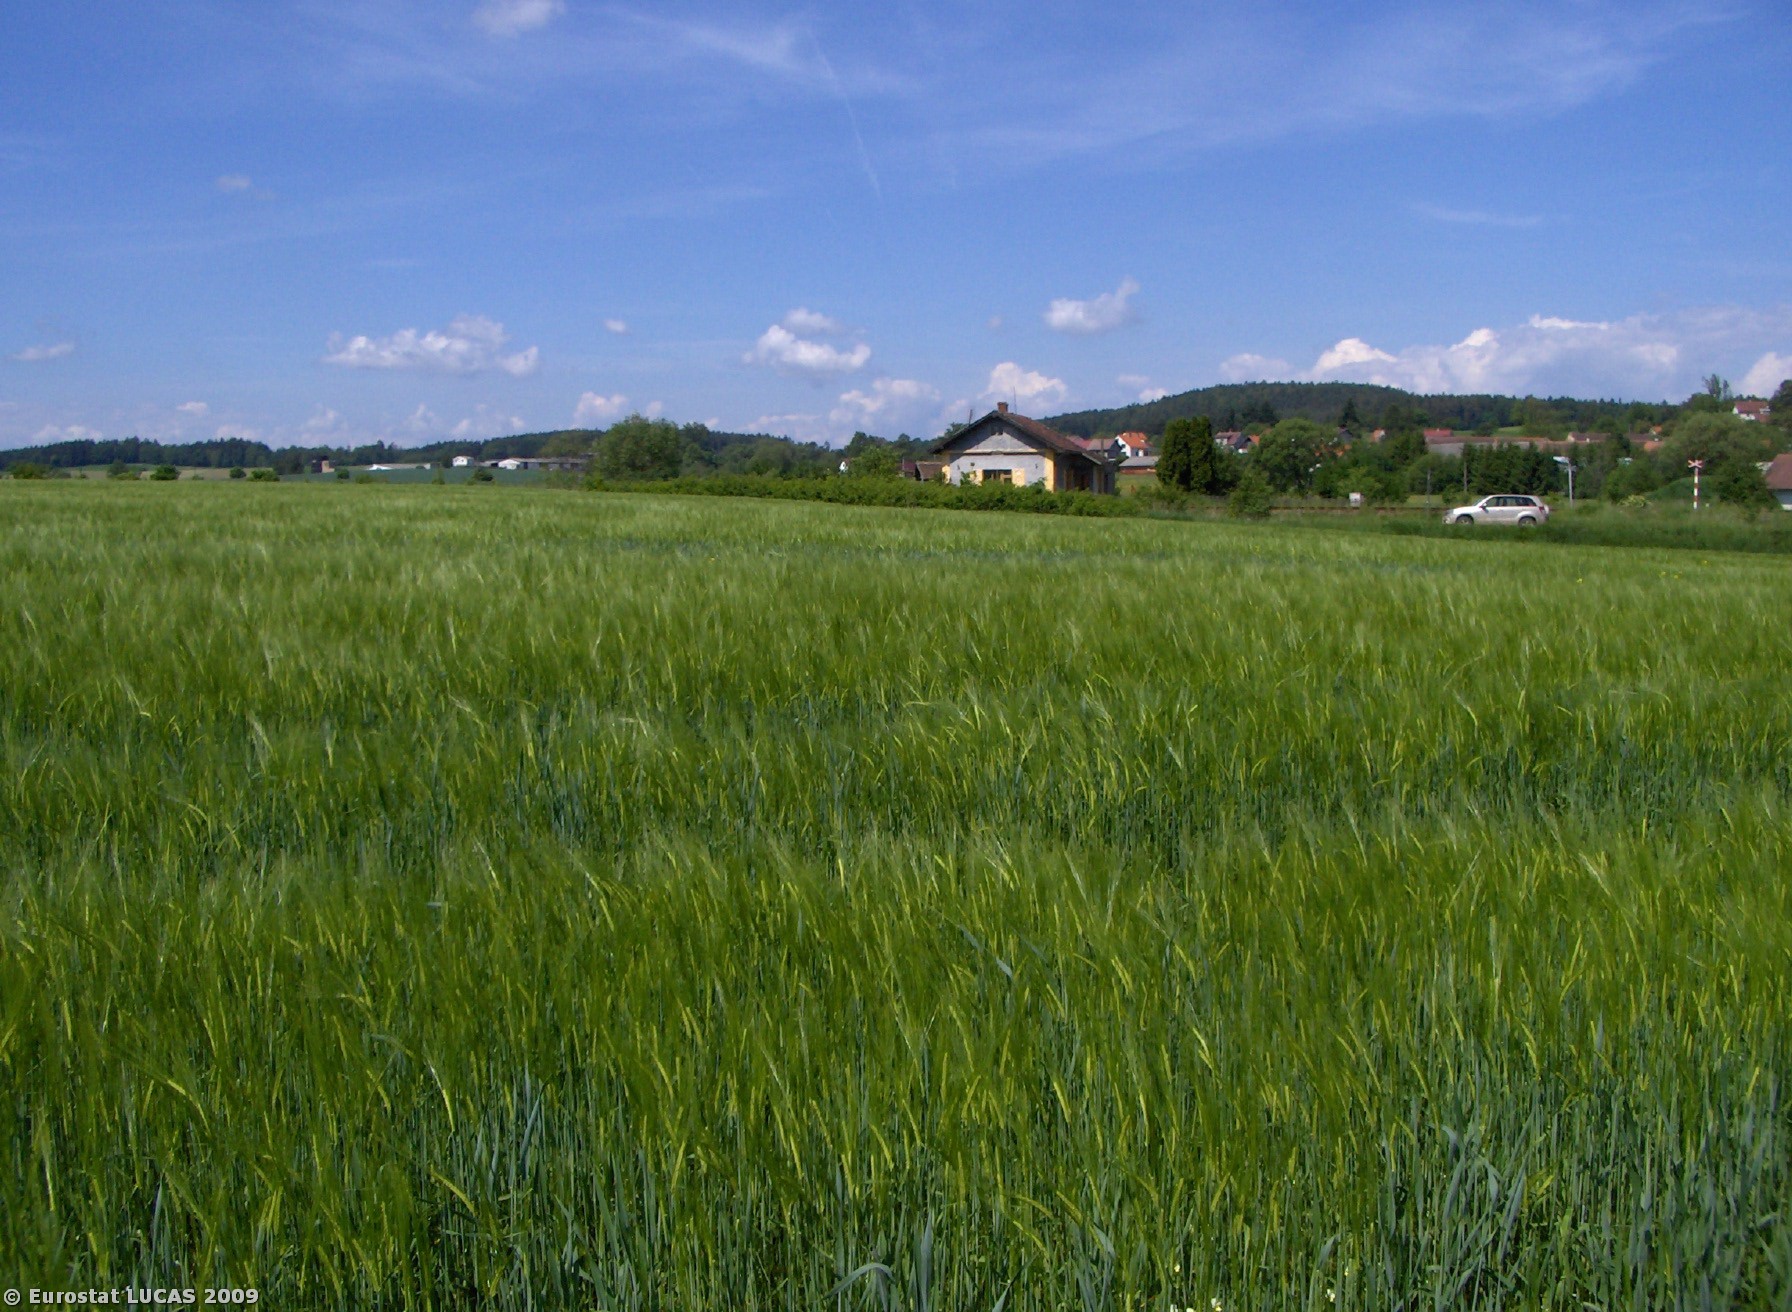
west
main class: Cropland
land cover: Barley
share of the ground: > 75 %
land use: Agriculture (excluding fallow land and kitchen gardens)
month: May
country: CZ
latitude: 49.3992
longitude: 14.3417
